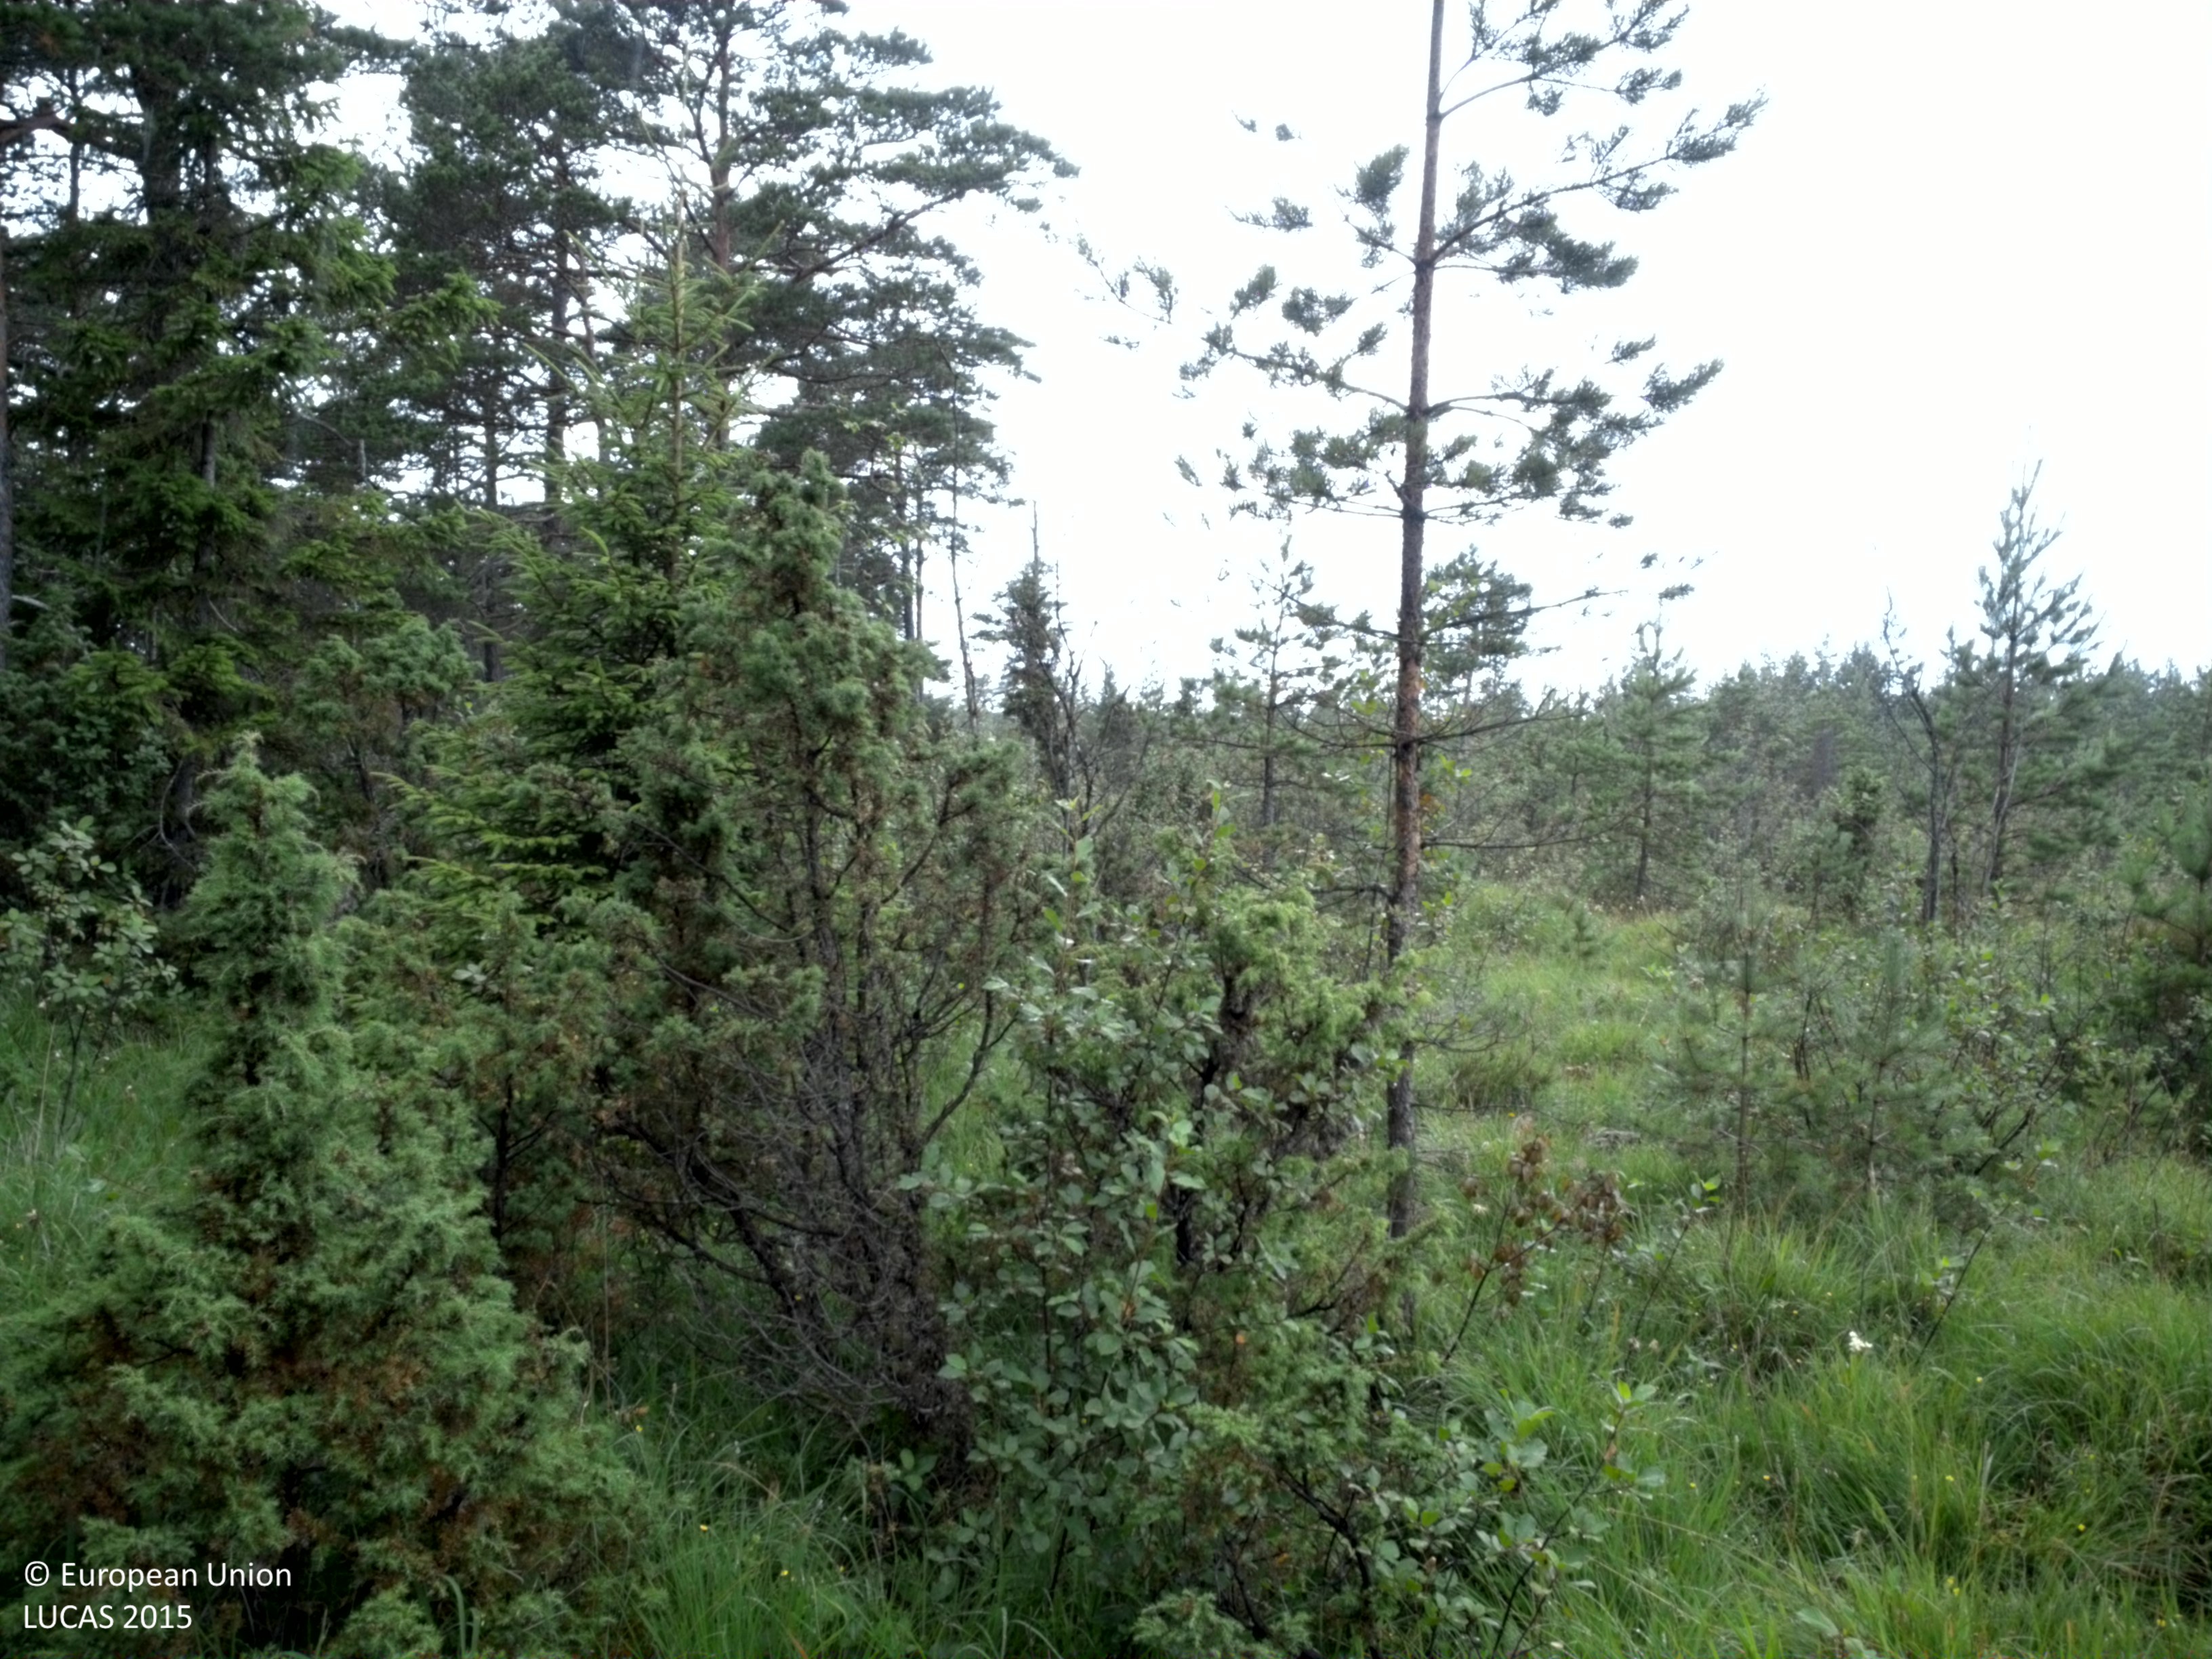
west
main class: Woodland
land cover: Pine dominated coniferous woodland
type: hemiboreal forest and nemoral coniferous forest and mixed broadleaved-coniferous forest
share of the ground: > 75 %
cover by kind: coniferous forest trees 60 %, herbaceous plants 20 %, shrubs 15 %, broadleaved forest trees 5 %
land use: Forestry
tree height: < 5 m
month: July
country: SE
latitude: 57.4867
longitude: 18.6673
